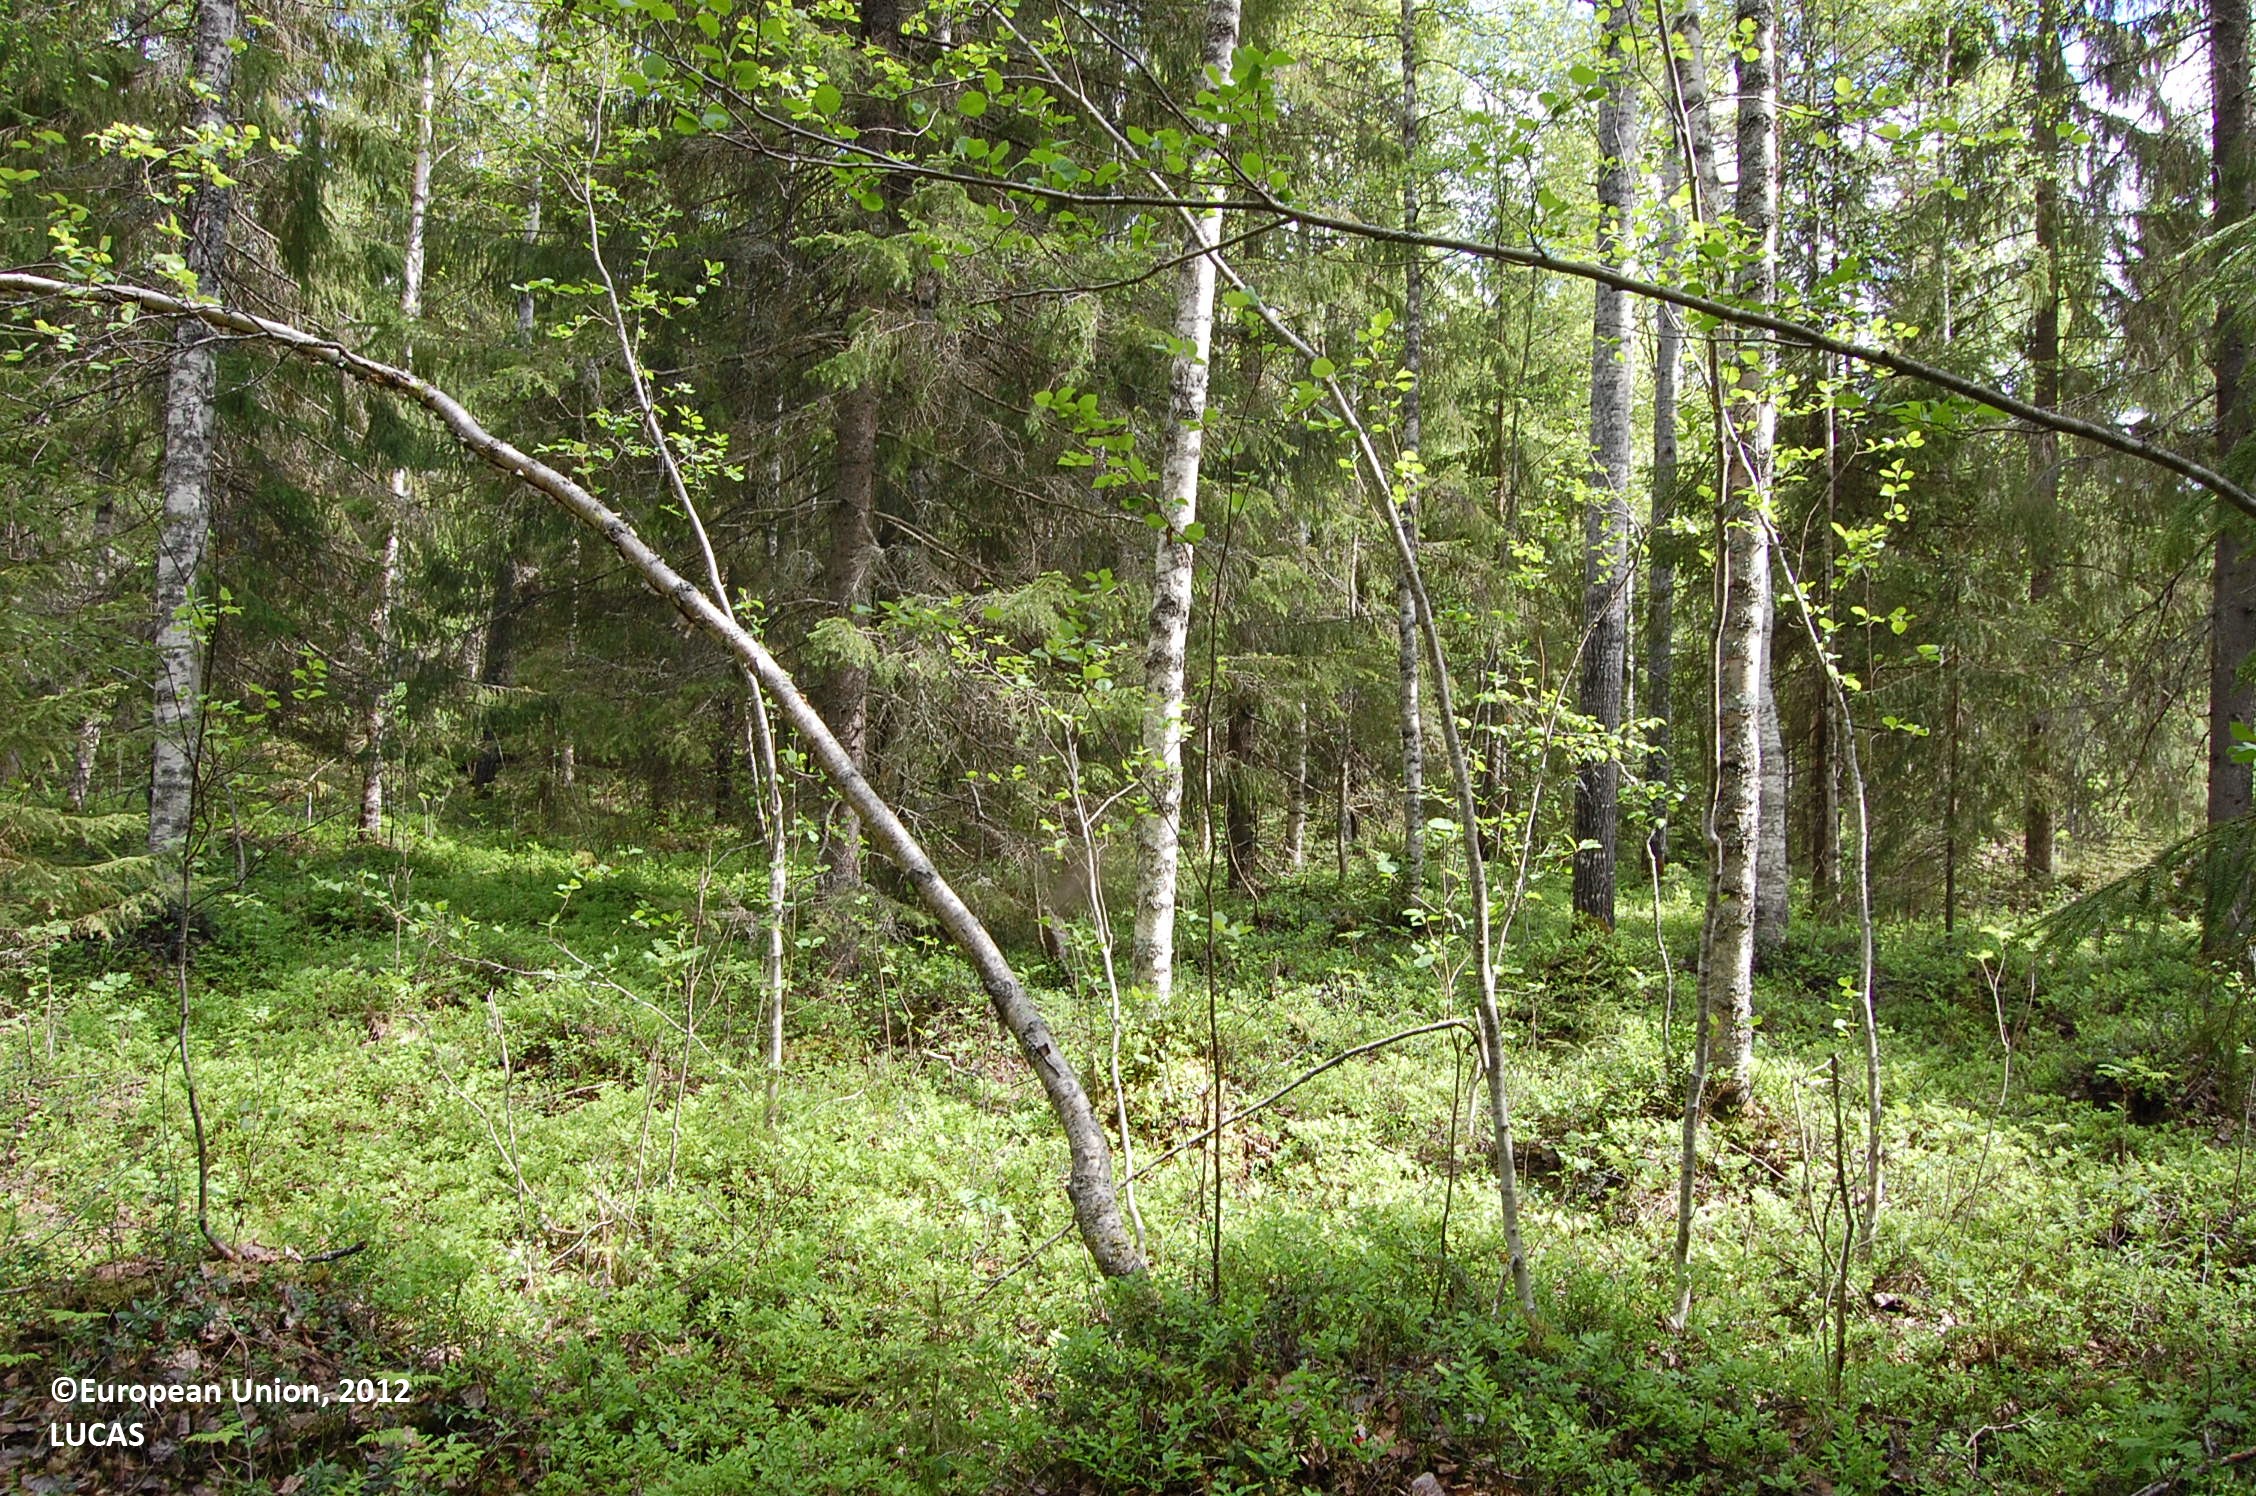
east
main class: Woodland
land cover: Spruce dominated mixed woodland
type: hemiboreal forest and nemoral coniferous forest and mixed broadleaved-coniferous forest
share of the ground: 50 - 75 %
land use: Forestry
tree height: > 5 m
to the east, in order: Spruce dominated mixed woodland; Tracks; Pine dominated coniferous woodland
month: June
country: FI
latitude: 64.0579
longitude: 26.1953
